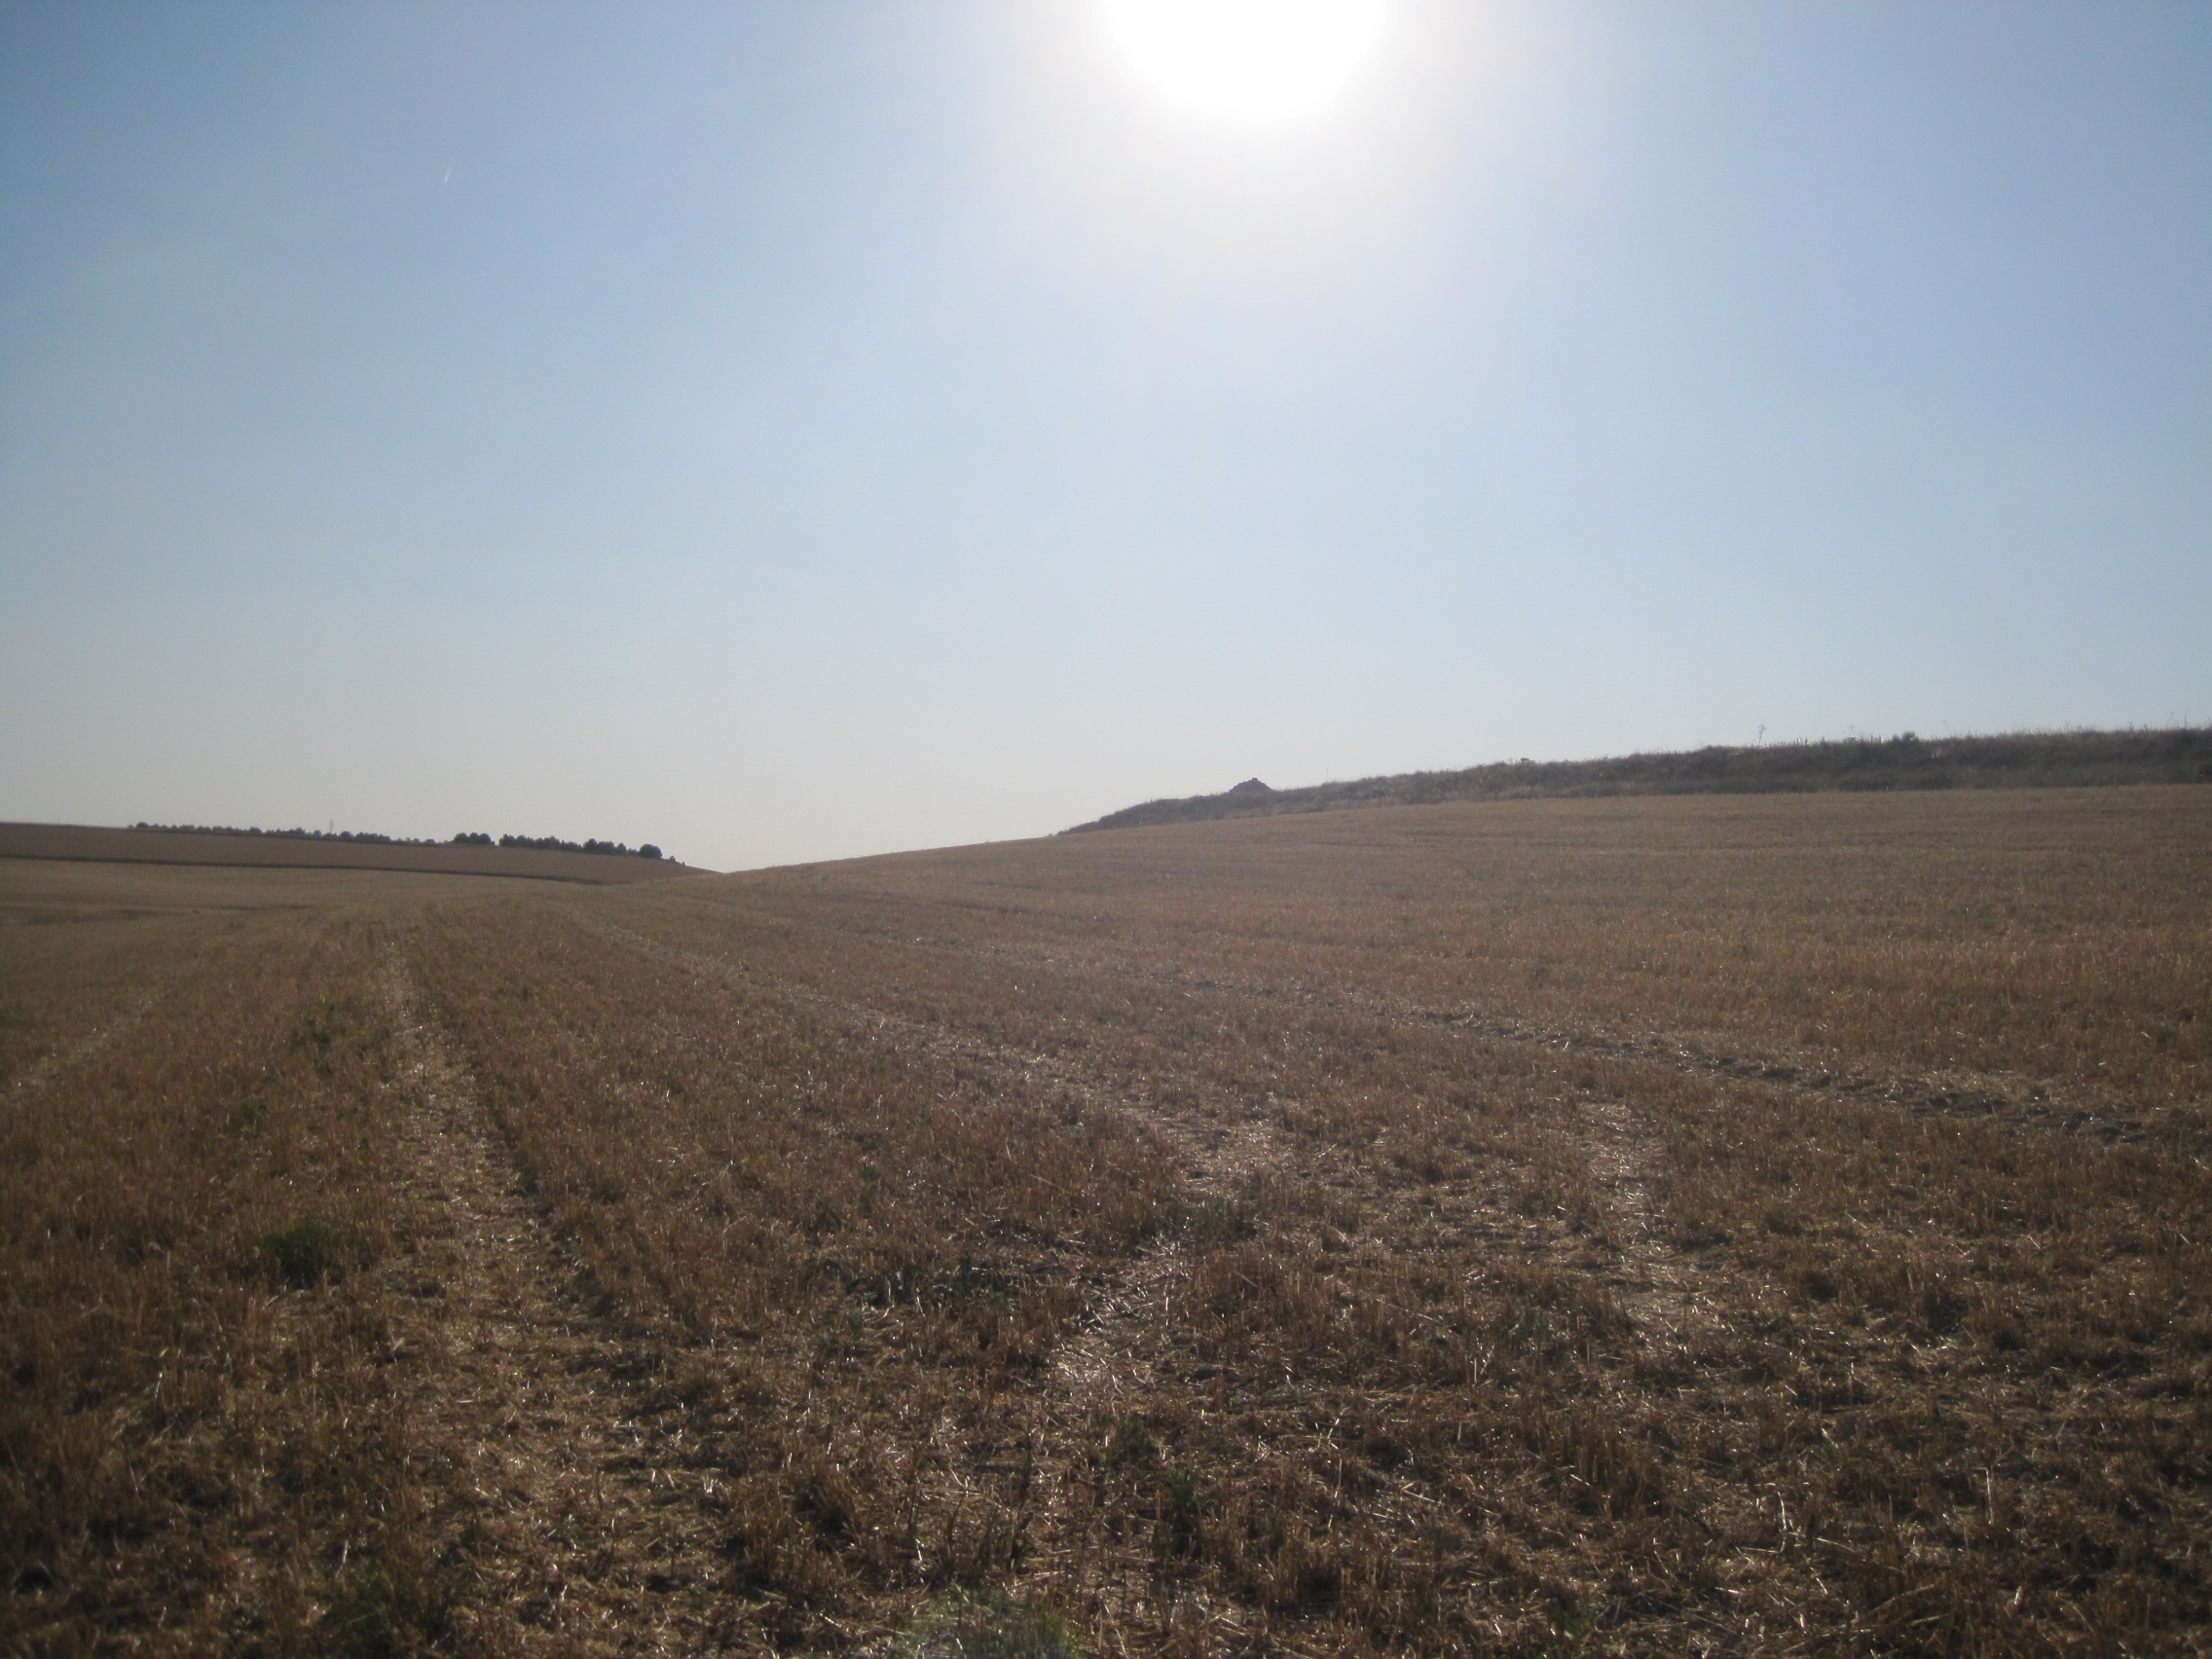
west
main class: Cropland
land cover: Barley
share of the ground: < 10 %
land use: Agriculture (excluding fallow land and kitchen gardens)
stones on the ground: 10 - 25 %
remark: Harvested field
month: July
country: ES
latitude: 41.6753
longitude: -5.1276
